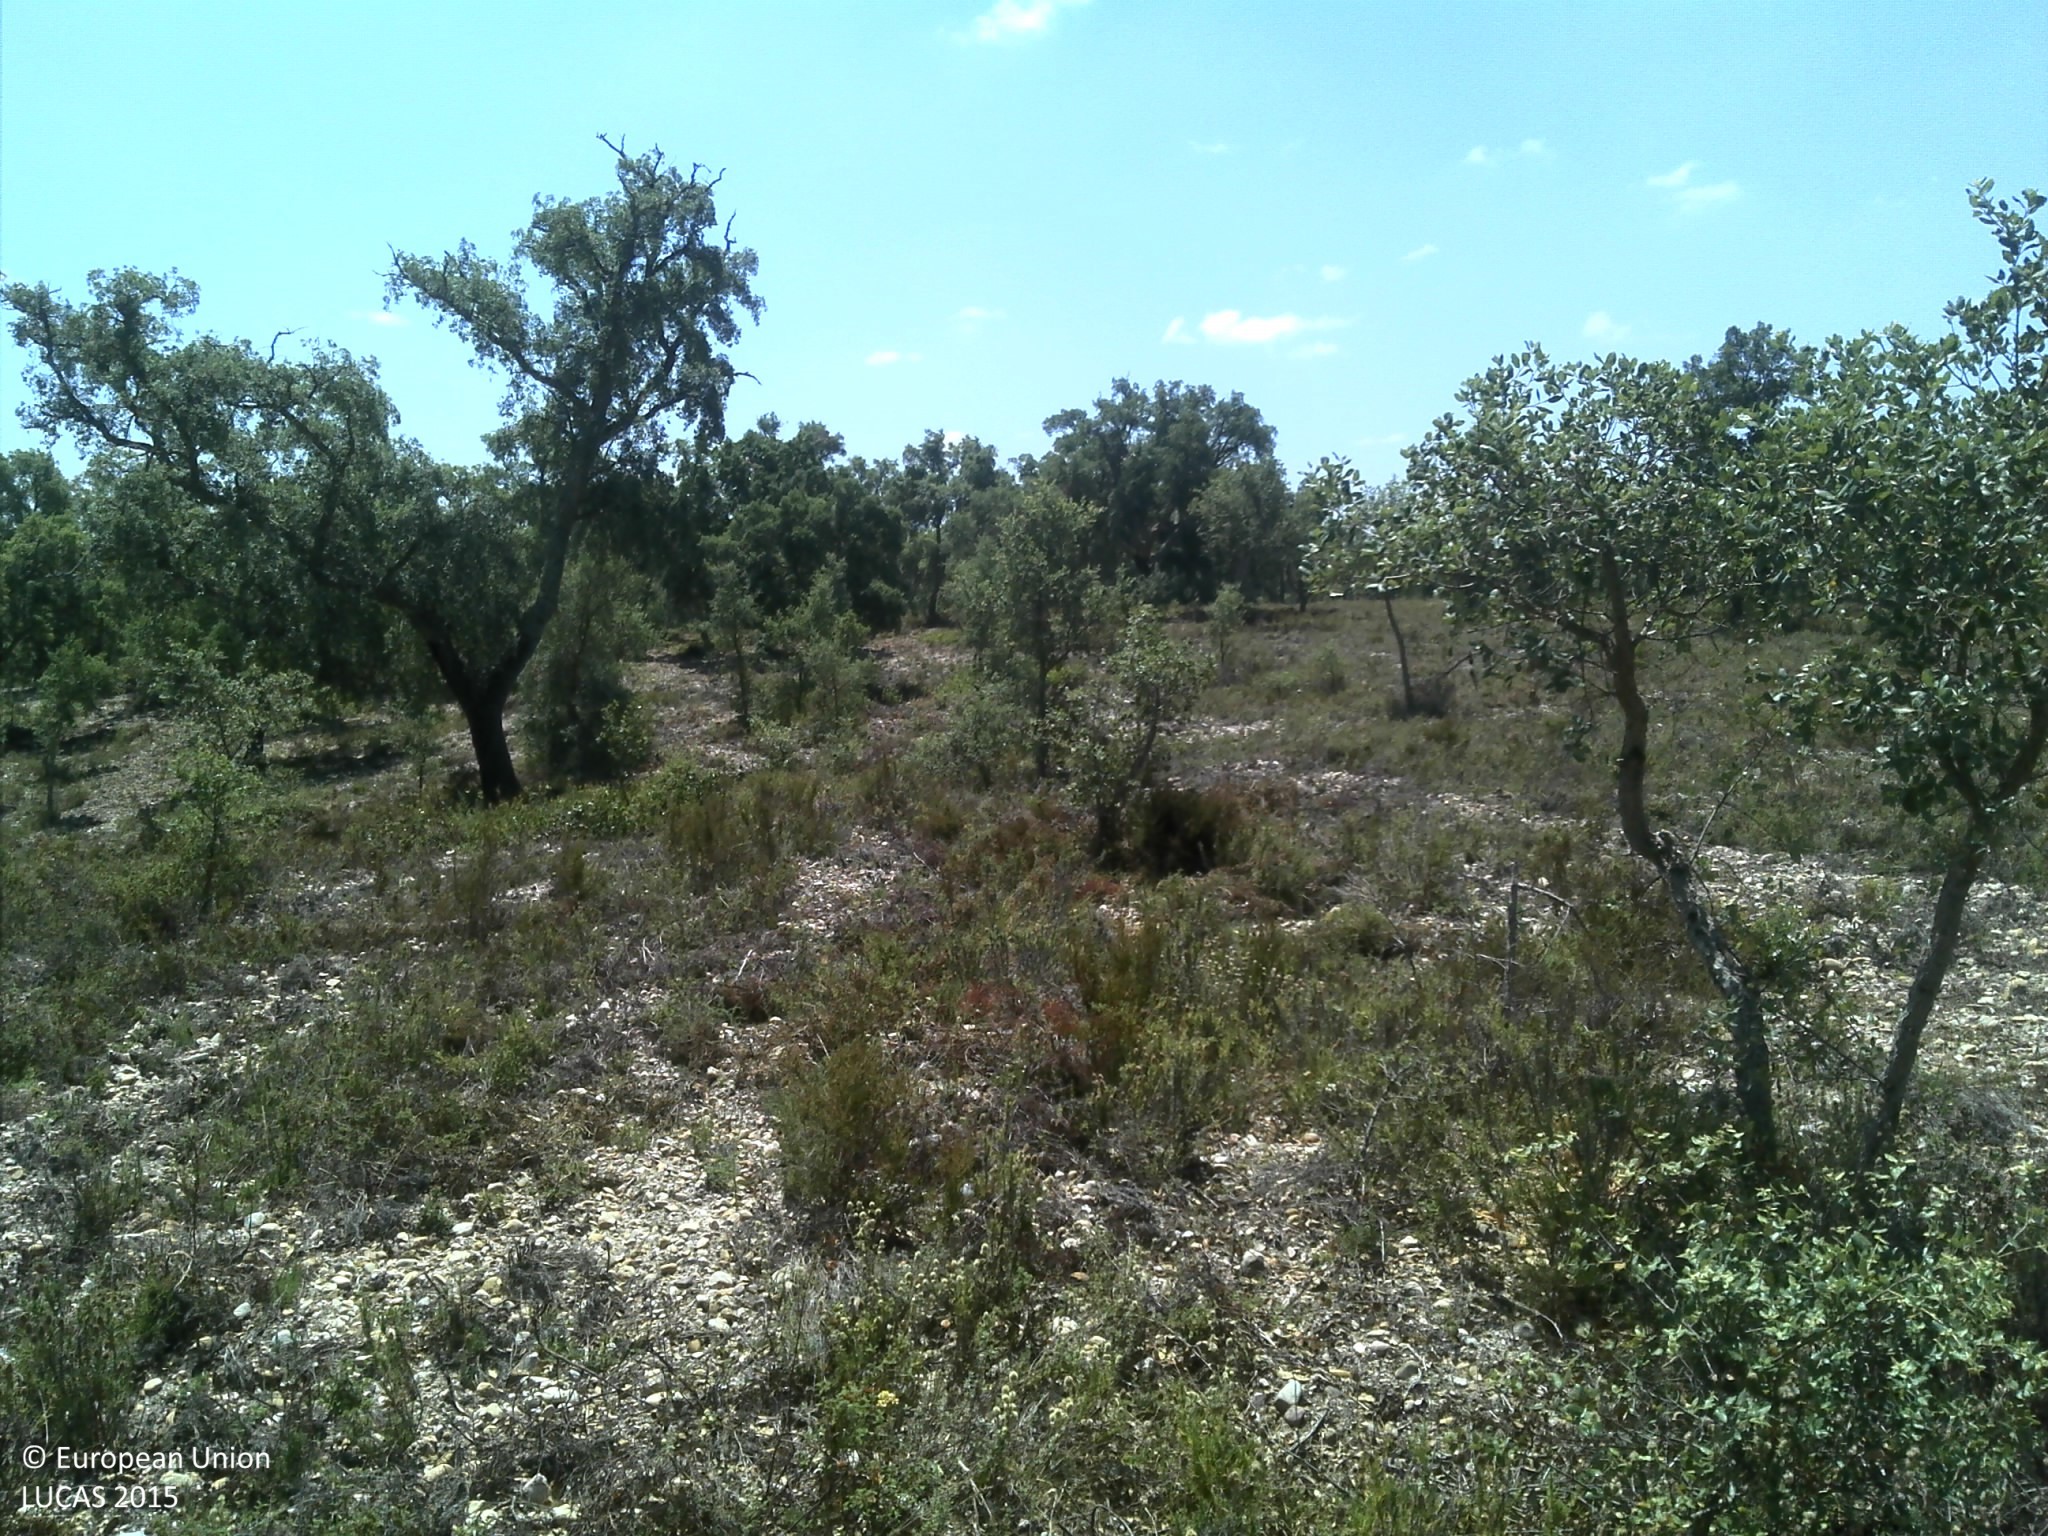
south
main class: Woodland
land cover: Broadleaved woodland
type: broadleaved evergreen forest
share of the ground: 10 - 25 %
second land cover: Grassland without tree/shrub cover
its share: 25 - 50 %
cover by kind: unconsolidated bare surface 40 %, broadleaved forest trees 25 %, herbaceous plants 25 %, shrubs 10 %
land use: Forestry
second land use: Agriculture (excluding fallow land and kitchen gardens)
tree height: > 5 m
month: June
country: PT
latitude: 39.2834
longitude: -8.3227
